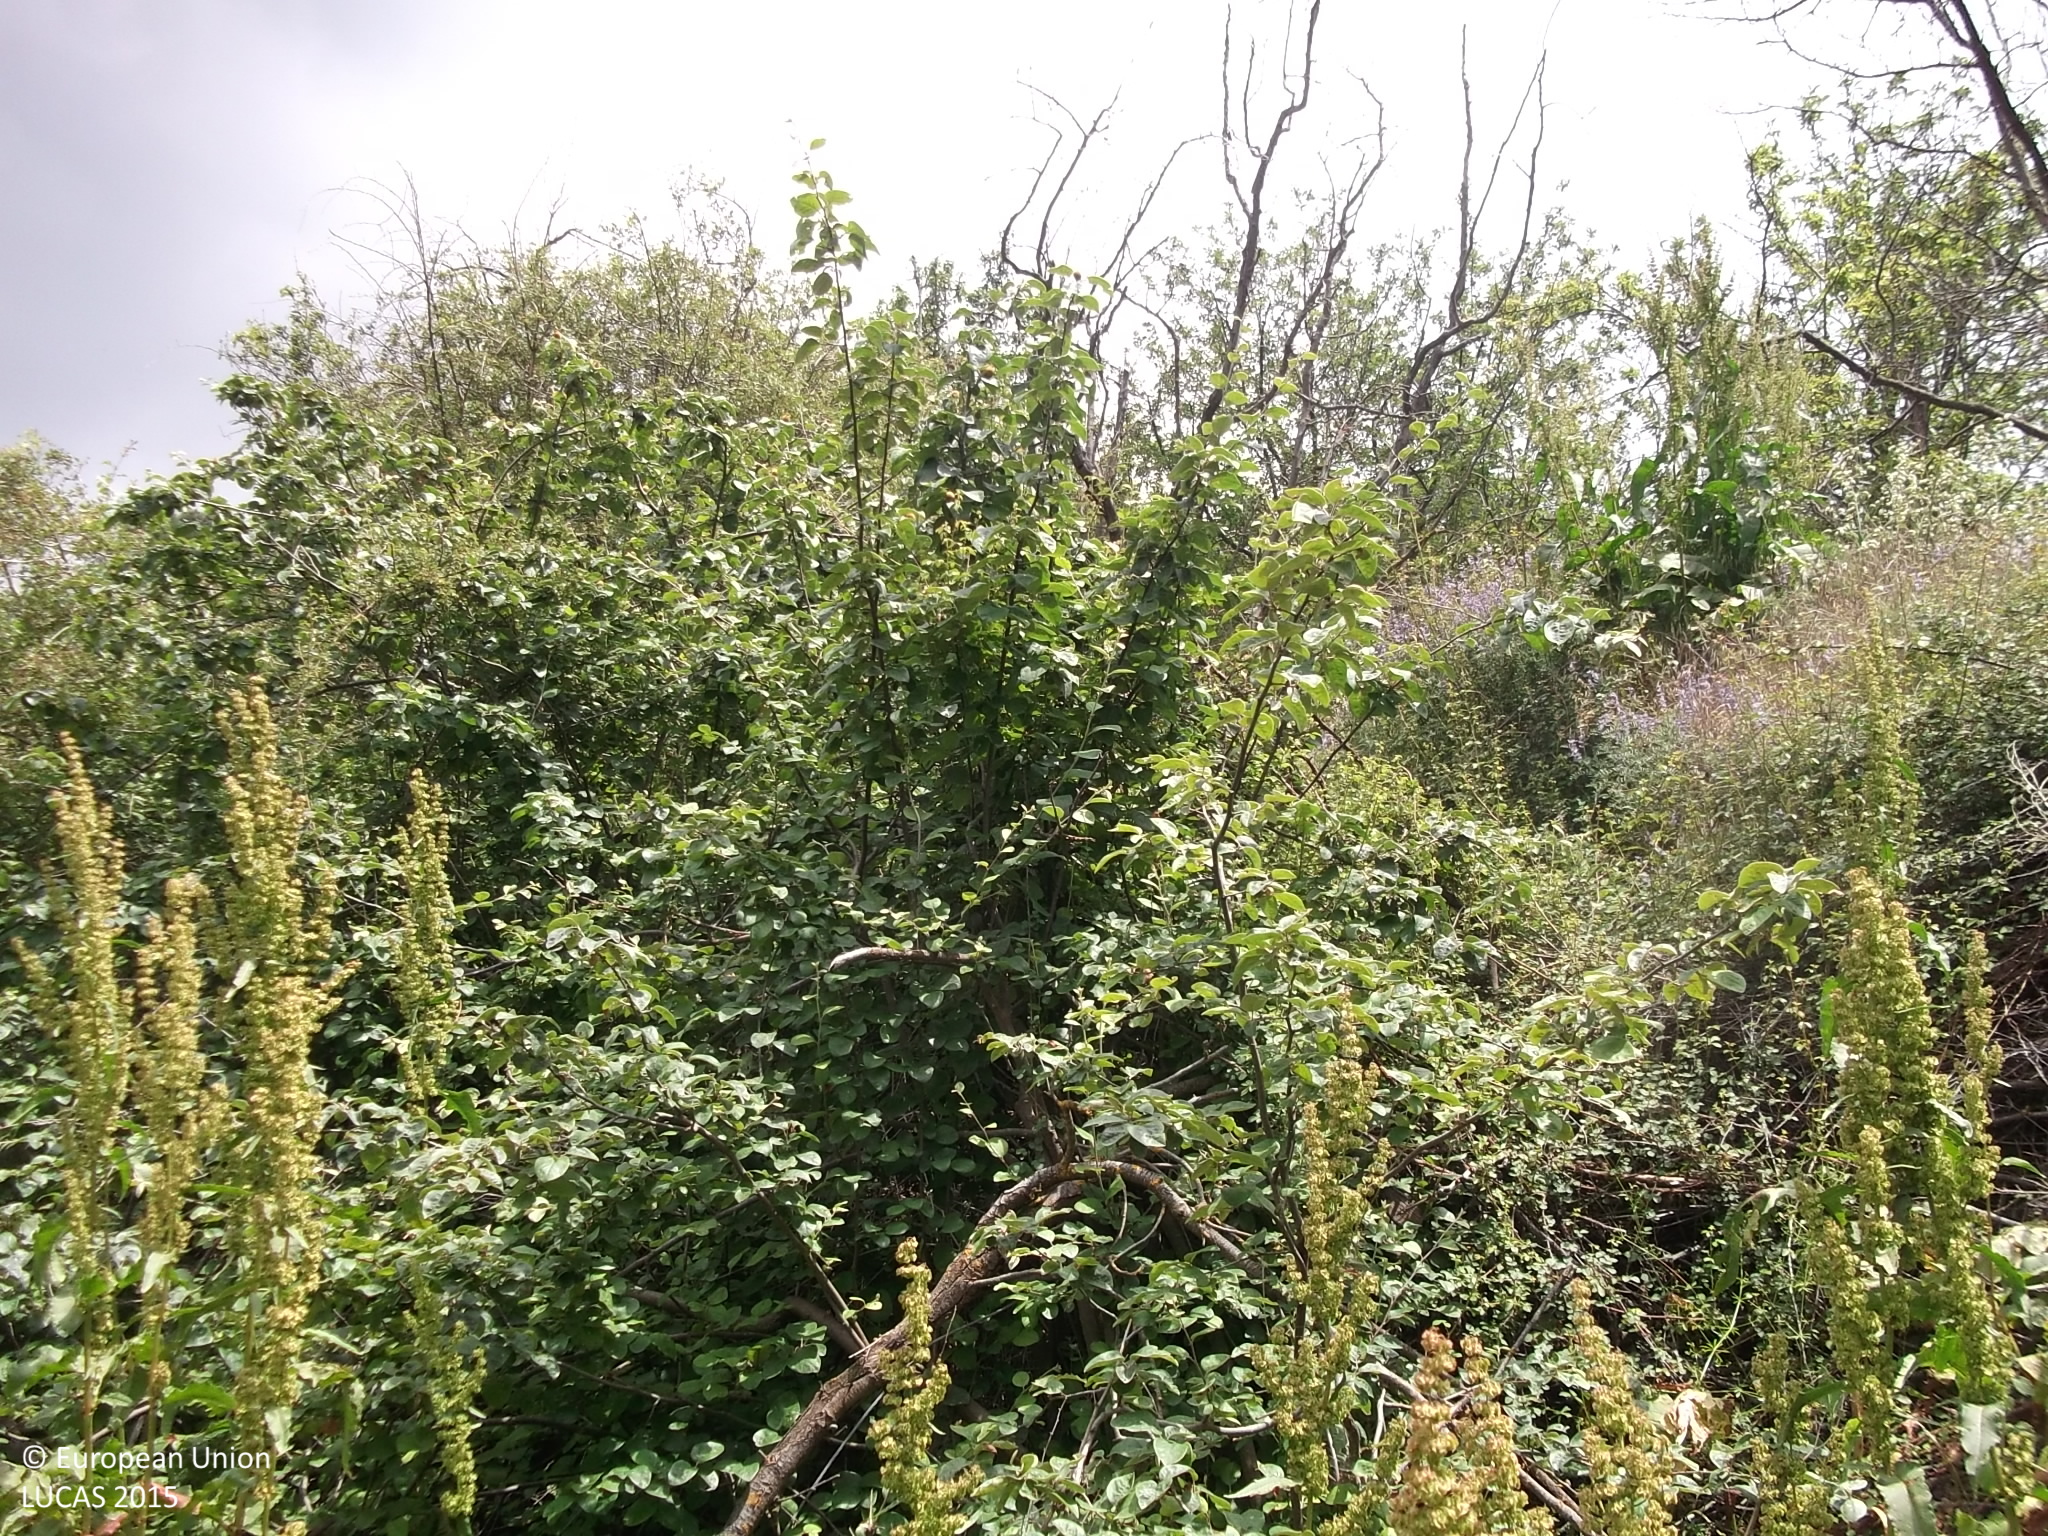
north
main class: Woodland
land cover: Pine dominated coniferous woodland
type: coniferous forest of the mediterranean region
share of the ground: > 75 %
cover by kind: coniferous forest trees 80 %, shrubs 10 %, unconsolidated bare surface 10 %
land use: Semi-natural and natural areas not in use
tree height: > 5 m
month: June
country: CY
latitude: 34.9544
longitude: 32.9591
